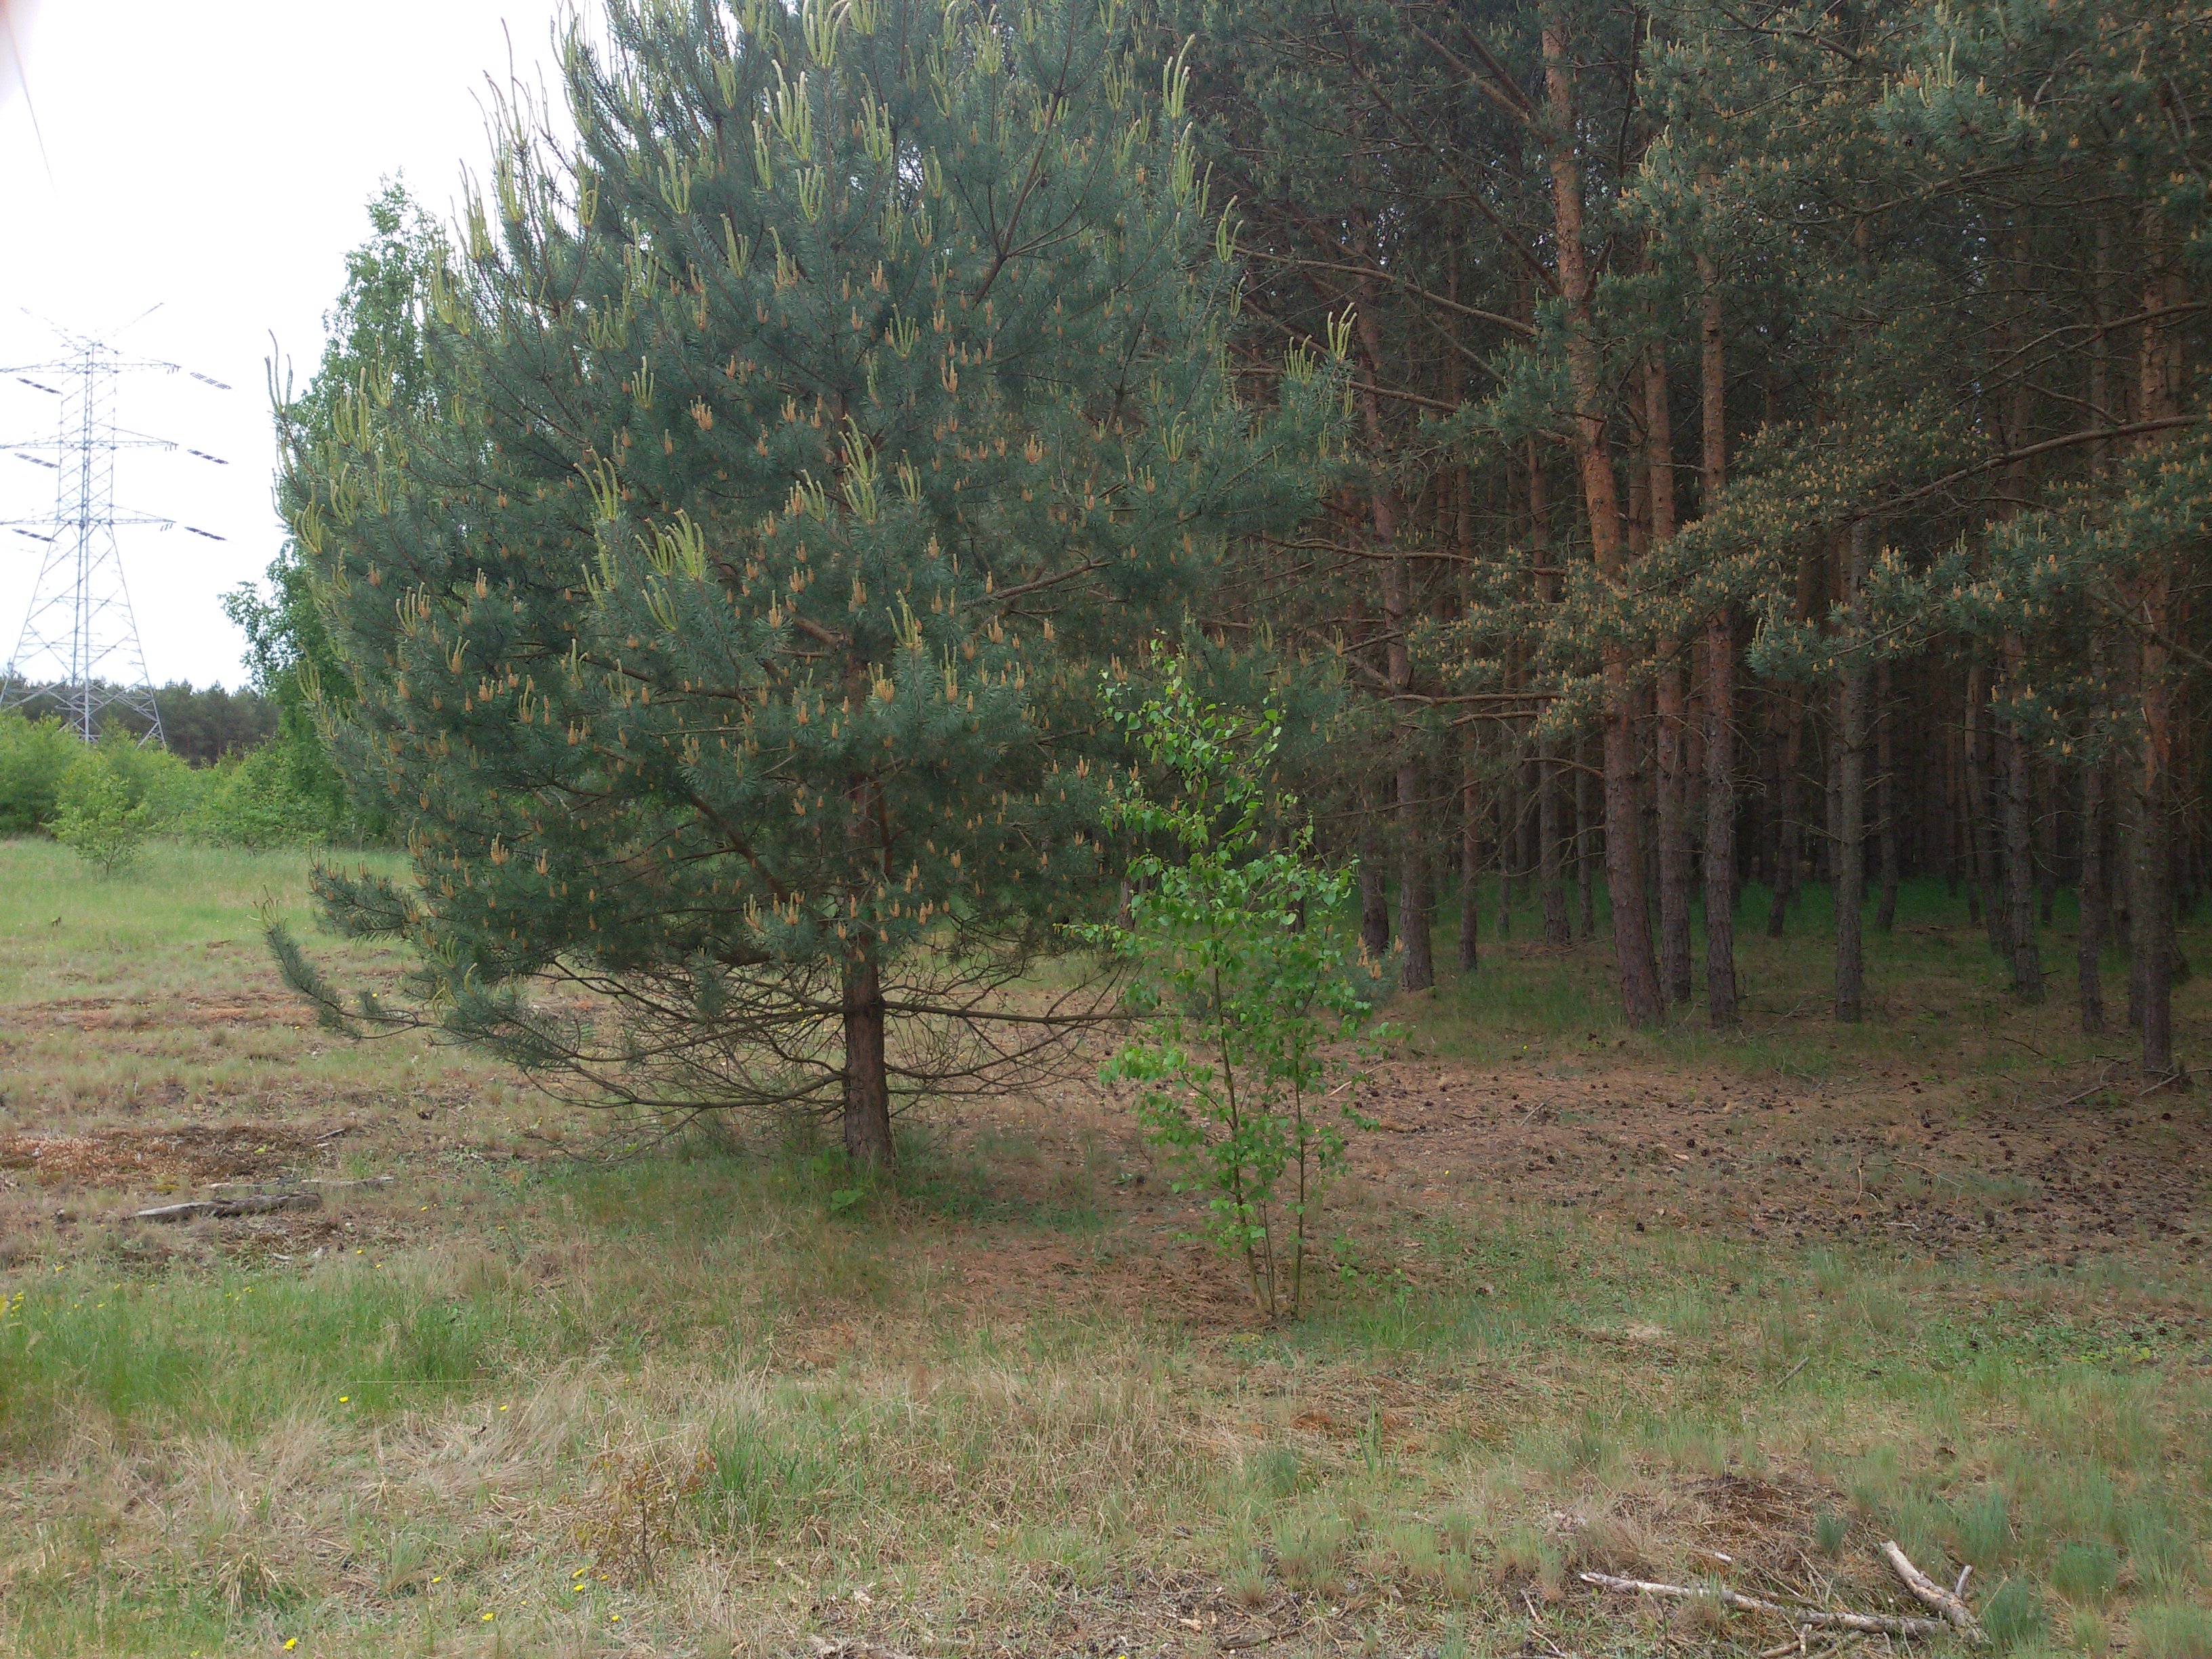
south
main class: Grassland
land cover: Grassland with sparse tree/shrub cover
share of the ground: > 75 %
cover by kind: herbaceous plants 95 %, coniferous forest trees 5 %
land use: Forestry
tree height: > 5 m
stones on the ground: < 10 %
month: May
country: PL
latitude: 53.1932
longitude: 14.4765
